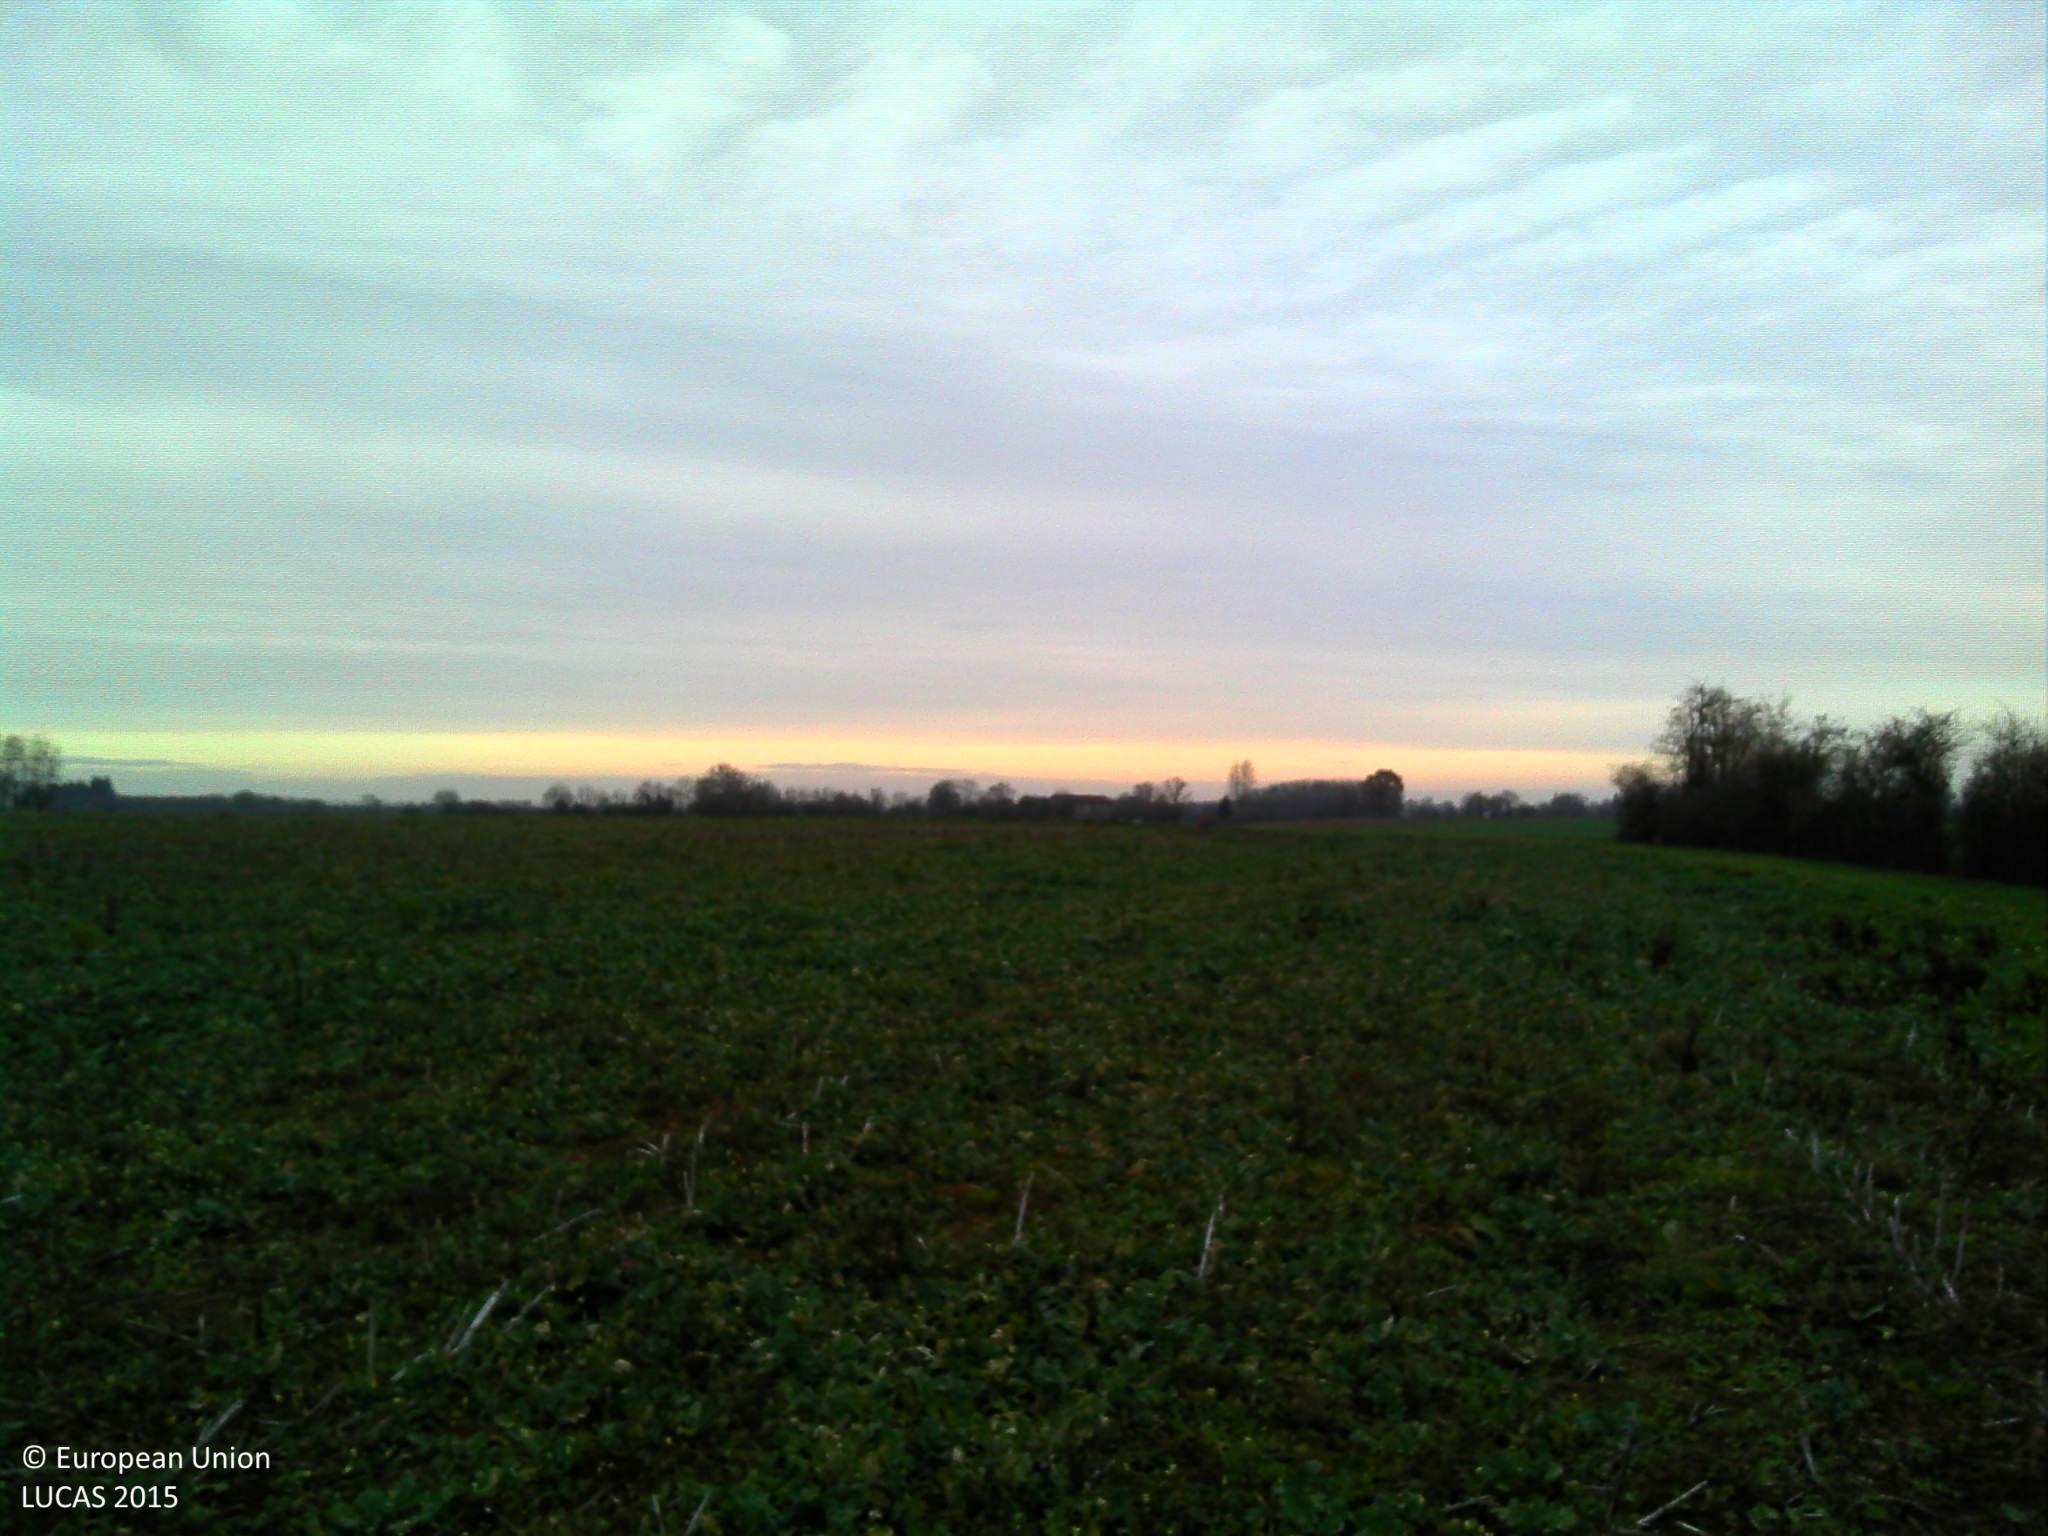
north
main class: Cropland
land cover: Rape and turnip rape
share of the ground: 50 - 75 %
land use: Agriculture (excluding fallow land and kitchen gardens)
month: December
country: FR
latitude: 46.1219
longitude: 5.3057
